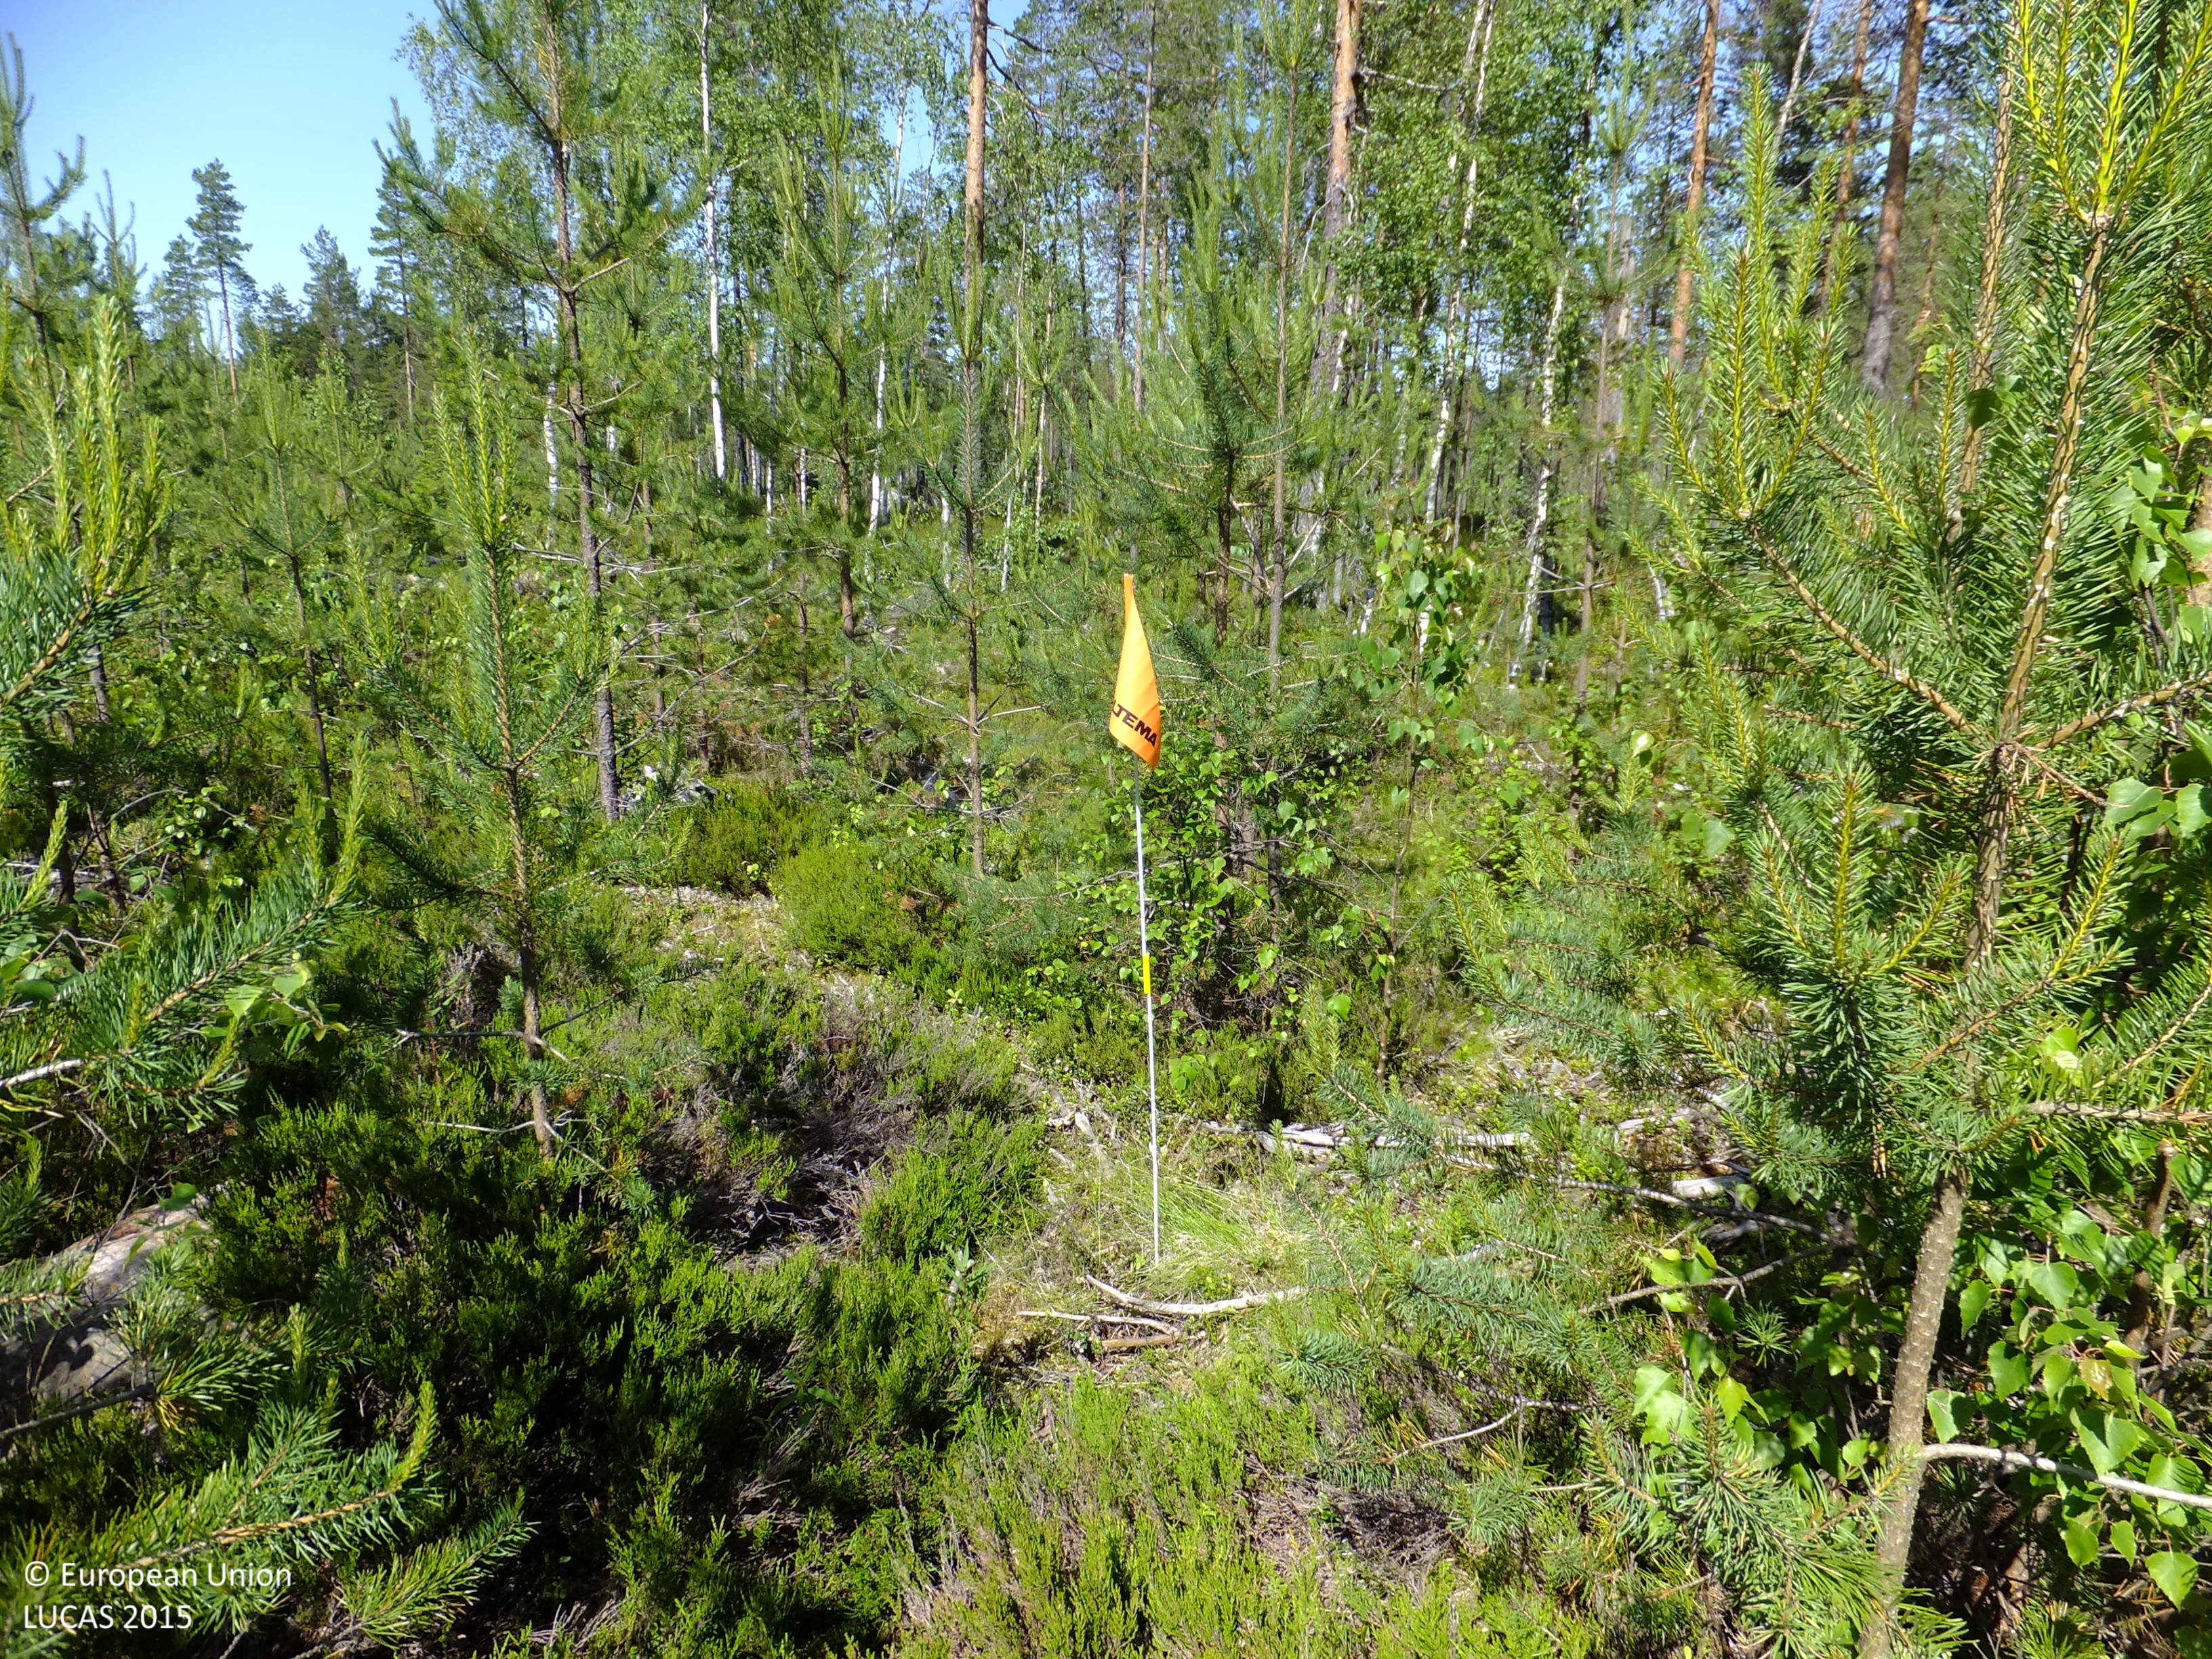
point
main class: Woodland
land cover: Pine dominated mixed woodland
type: boreal forest
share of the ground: 25 - 50 %
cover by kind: shrubs 40 %, coniferous forest trees 25 %, broadleaved forest trees 15 %, herbaceous plants 10 %, lichens and mosses 10 %
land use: Forestry
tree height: < 5 m
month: July
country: FI
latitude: 63.2744
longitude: 24.6141
